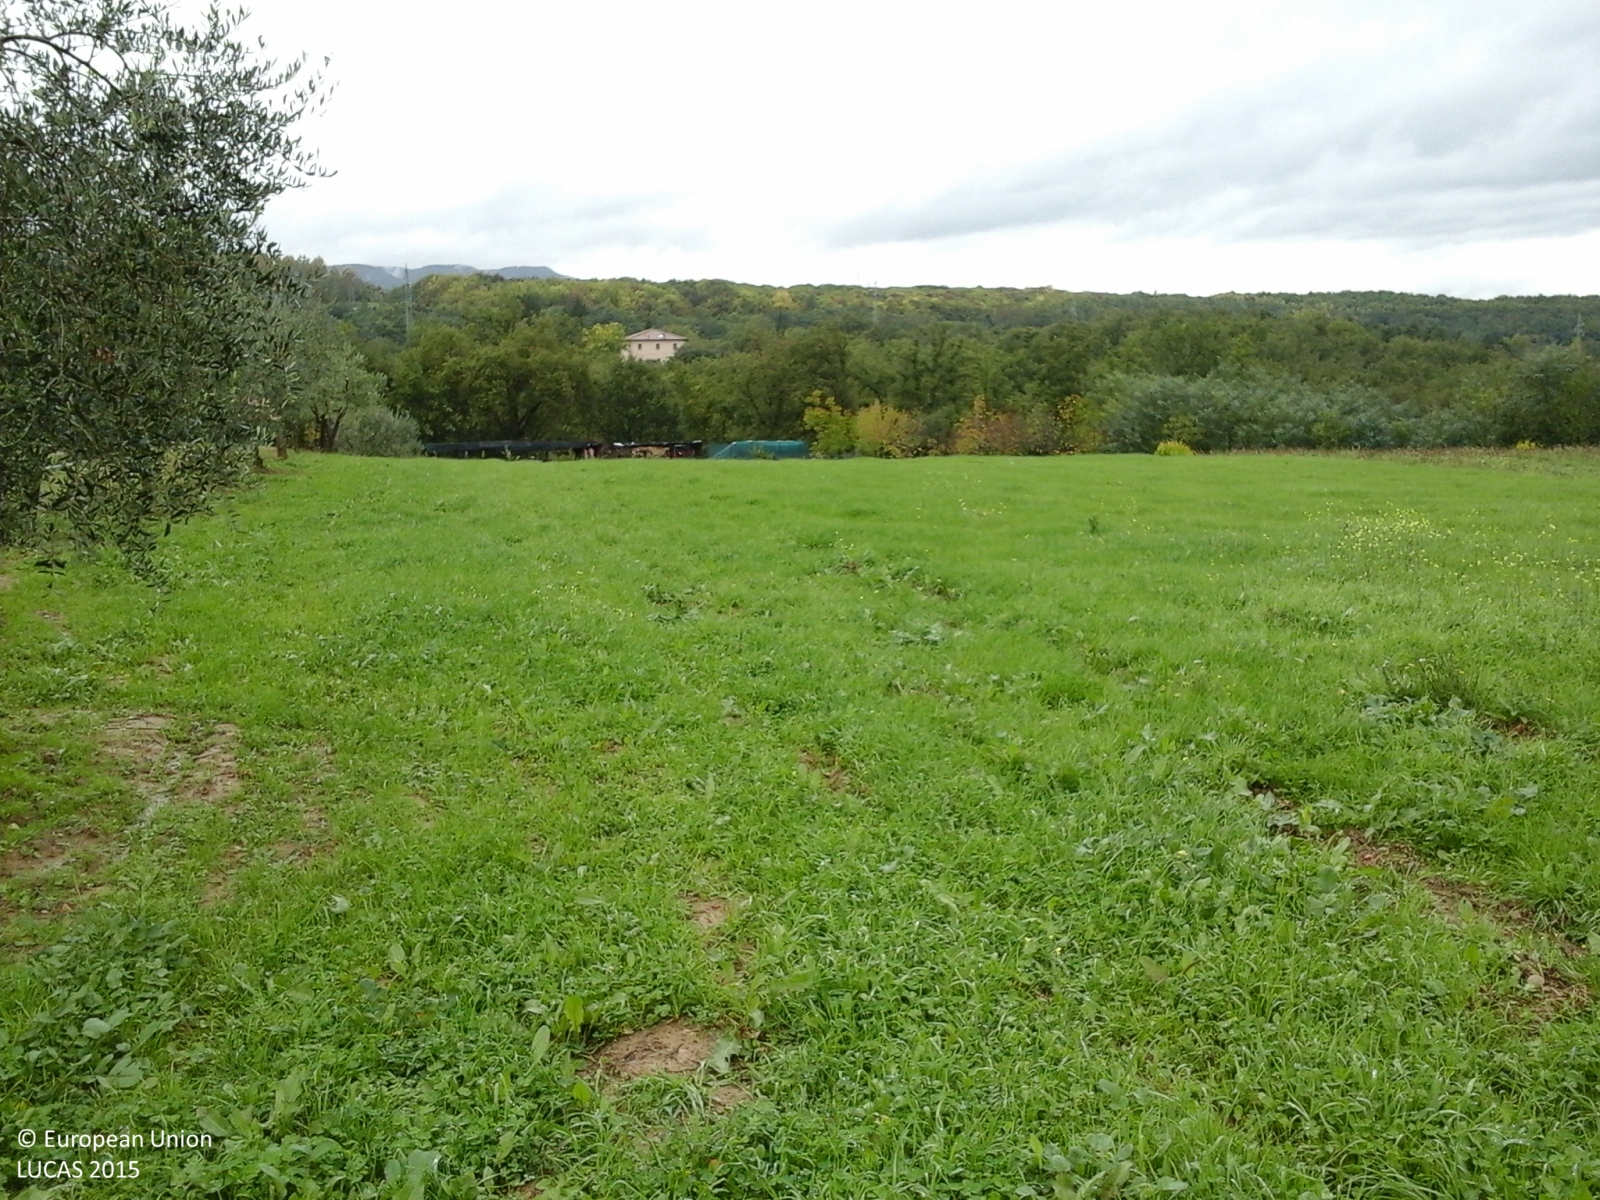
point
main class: Woodland
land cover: Broadleaved woodland
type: thermophilous deciduous forest
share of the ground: > 75 %
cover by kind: broadleaved forest trees 90 %, shrubs 10 %
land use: Forestry
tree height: > 5 m
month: October
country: IT
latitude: 43.5278
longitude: 11.4931
